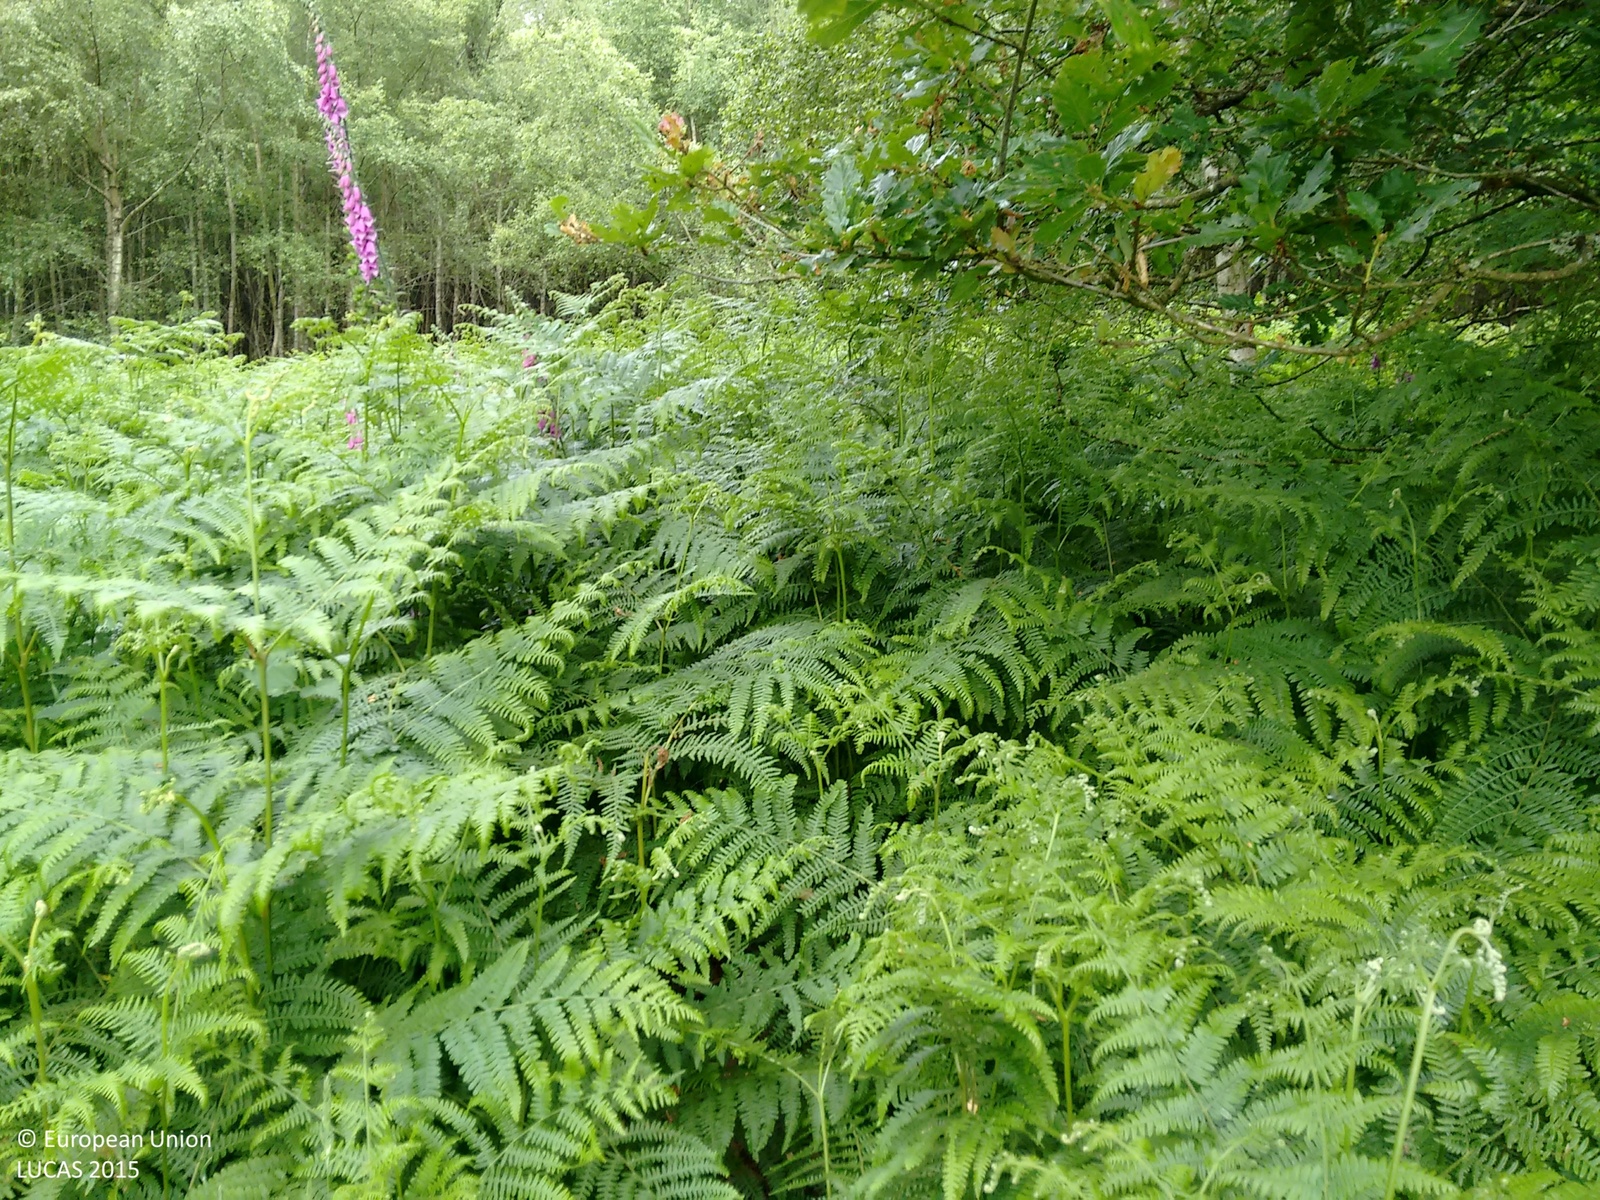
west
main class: Woodland
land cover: Broadleaved woodland
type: mesophytic deciduous forest
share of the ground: > 75 %
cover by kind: broadleaved forest trees 95 %, shrubs 5 %
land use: Semi-natural and natural areas not in use
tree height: > 5 m
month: June
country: GB
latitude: 52.3433
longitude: -2.7380
